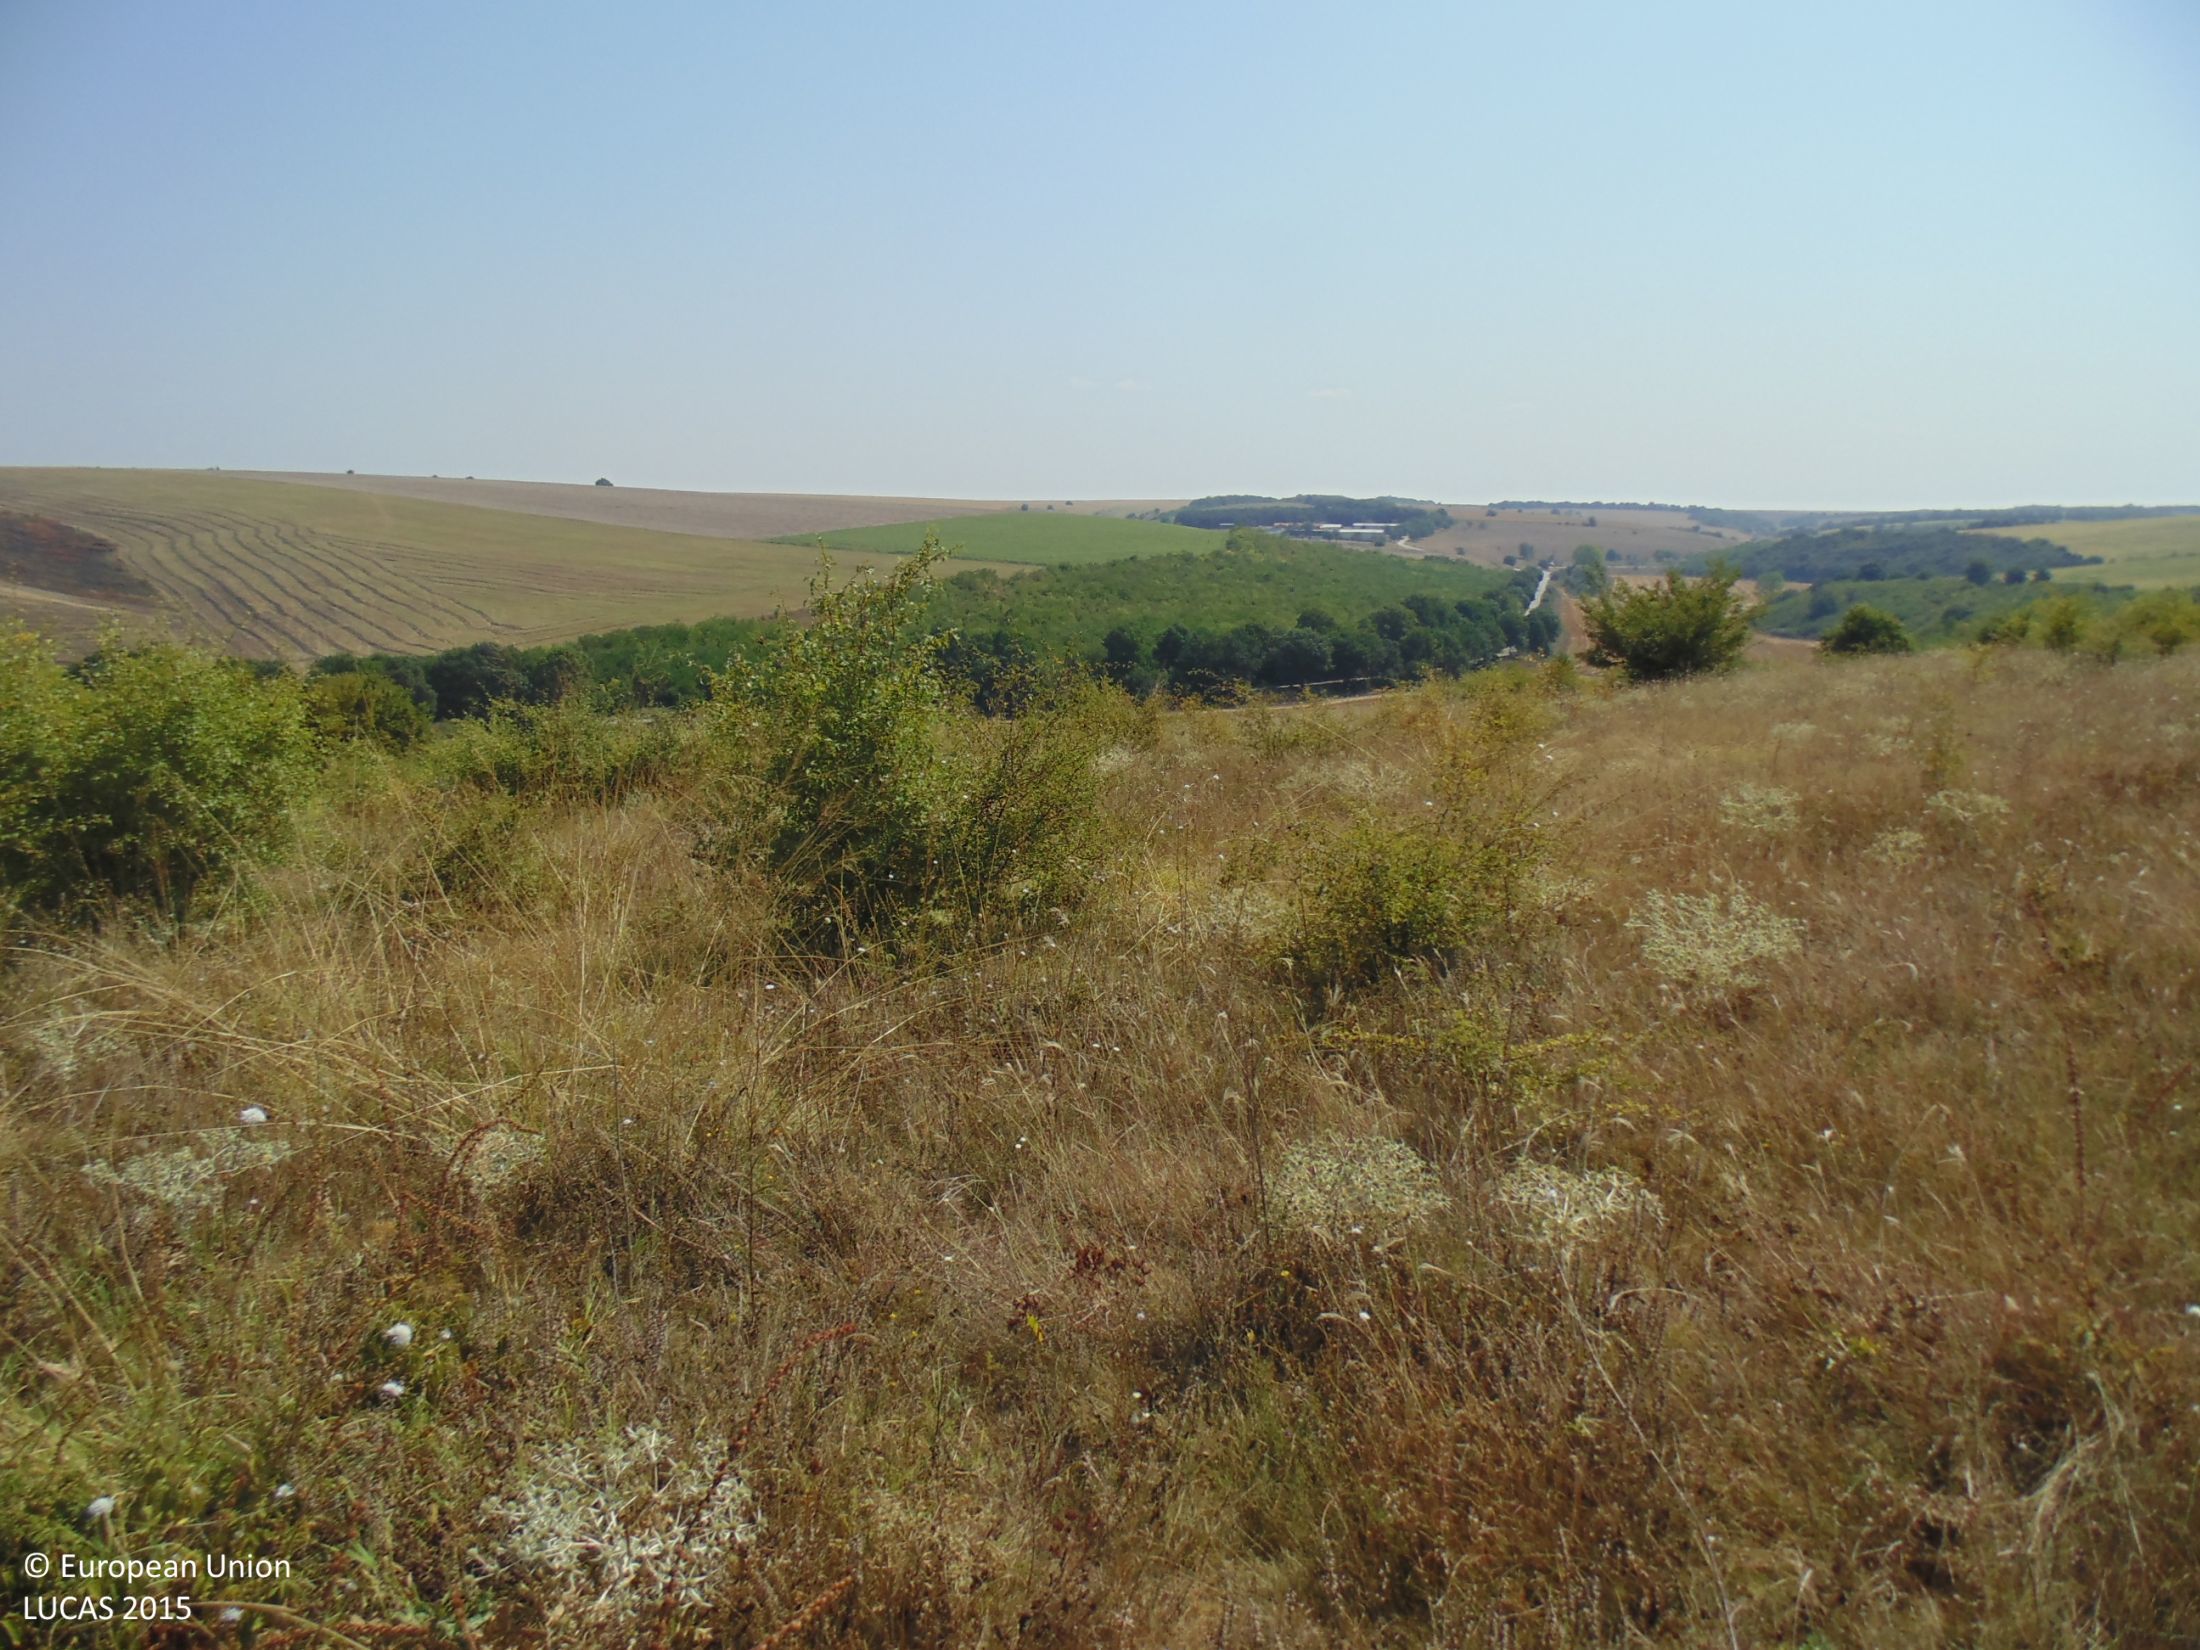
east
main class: Grassland
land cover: Grassland with sparse tree/shrub cover
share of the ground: > 75 %
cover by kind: herbaceous plants 90 %, broadleaved forest trees 5 %, shrubs 5 %
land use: Agriculture (excluding fallow land and kitchen gardens)
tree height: < 5 m
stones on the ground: < 10 %
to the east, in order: Grassland with sparse tree/shrub cover; Common wheat
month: August
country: BG
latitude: 43.9819
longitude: 27.5550
